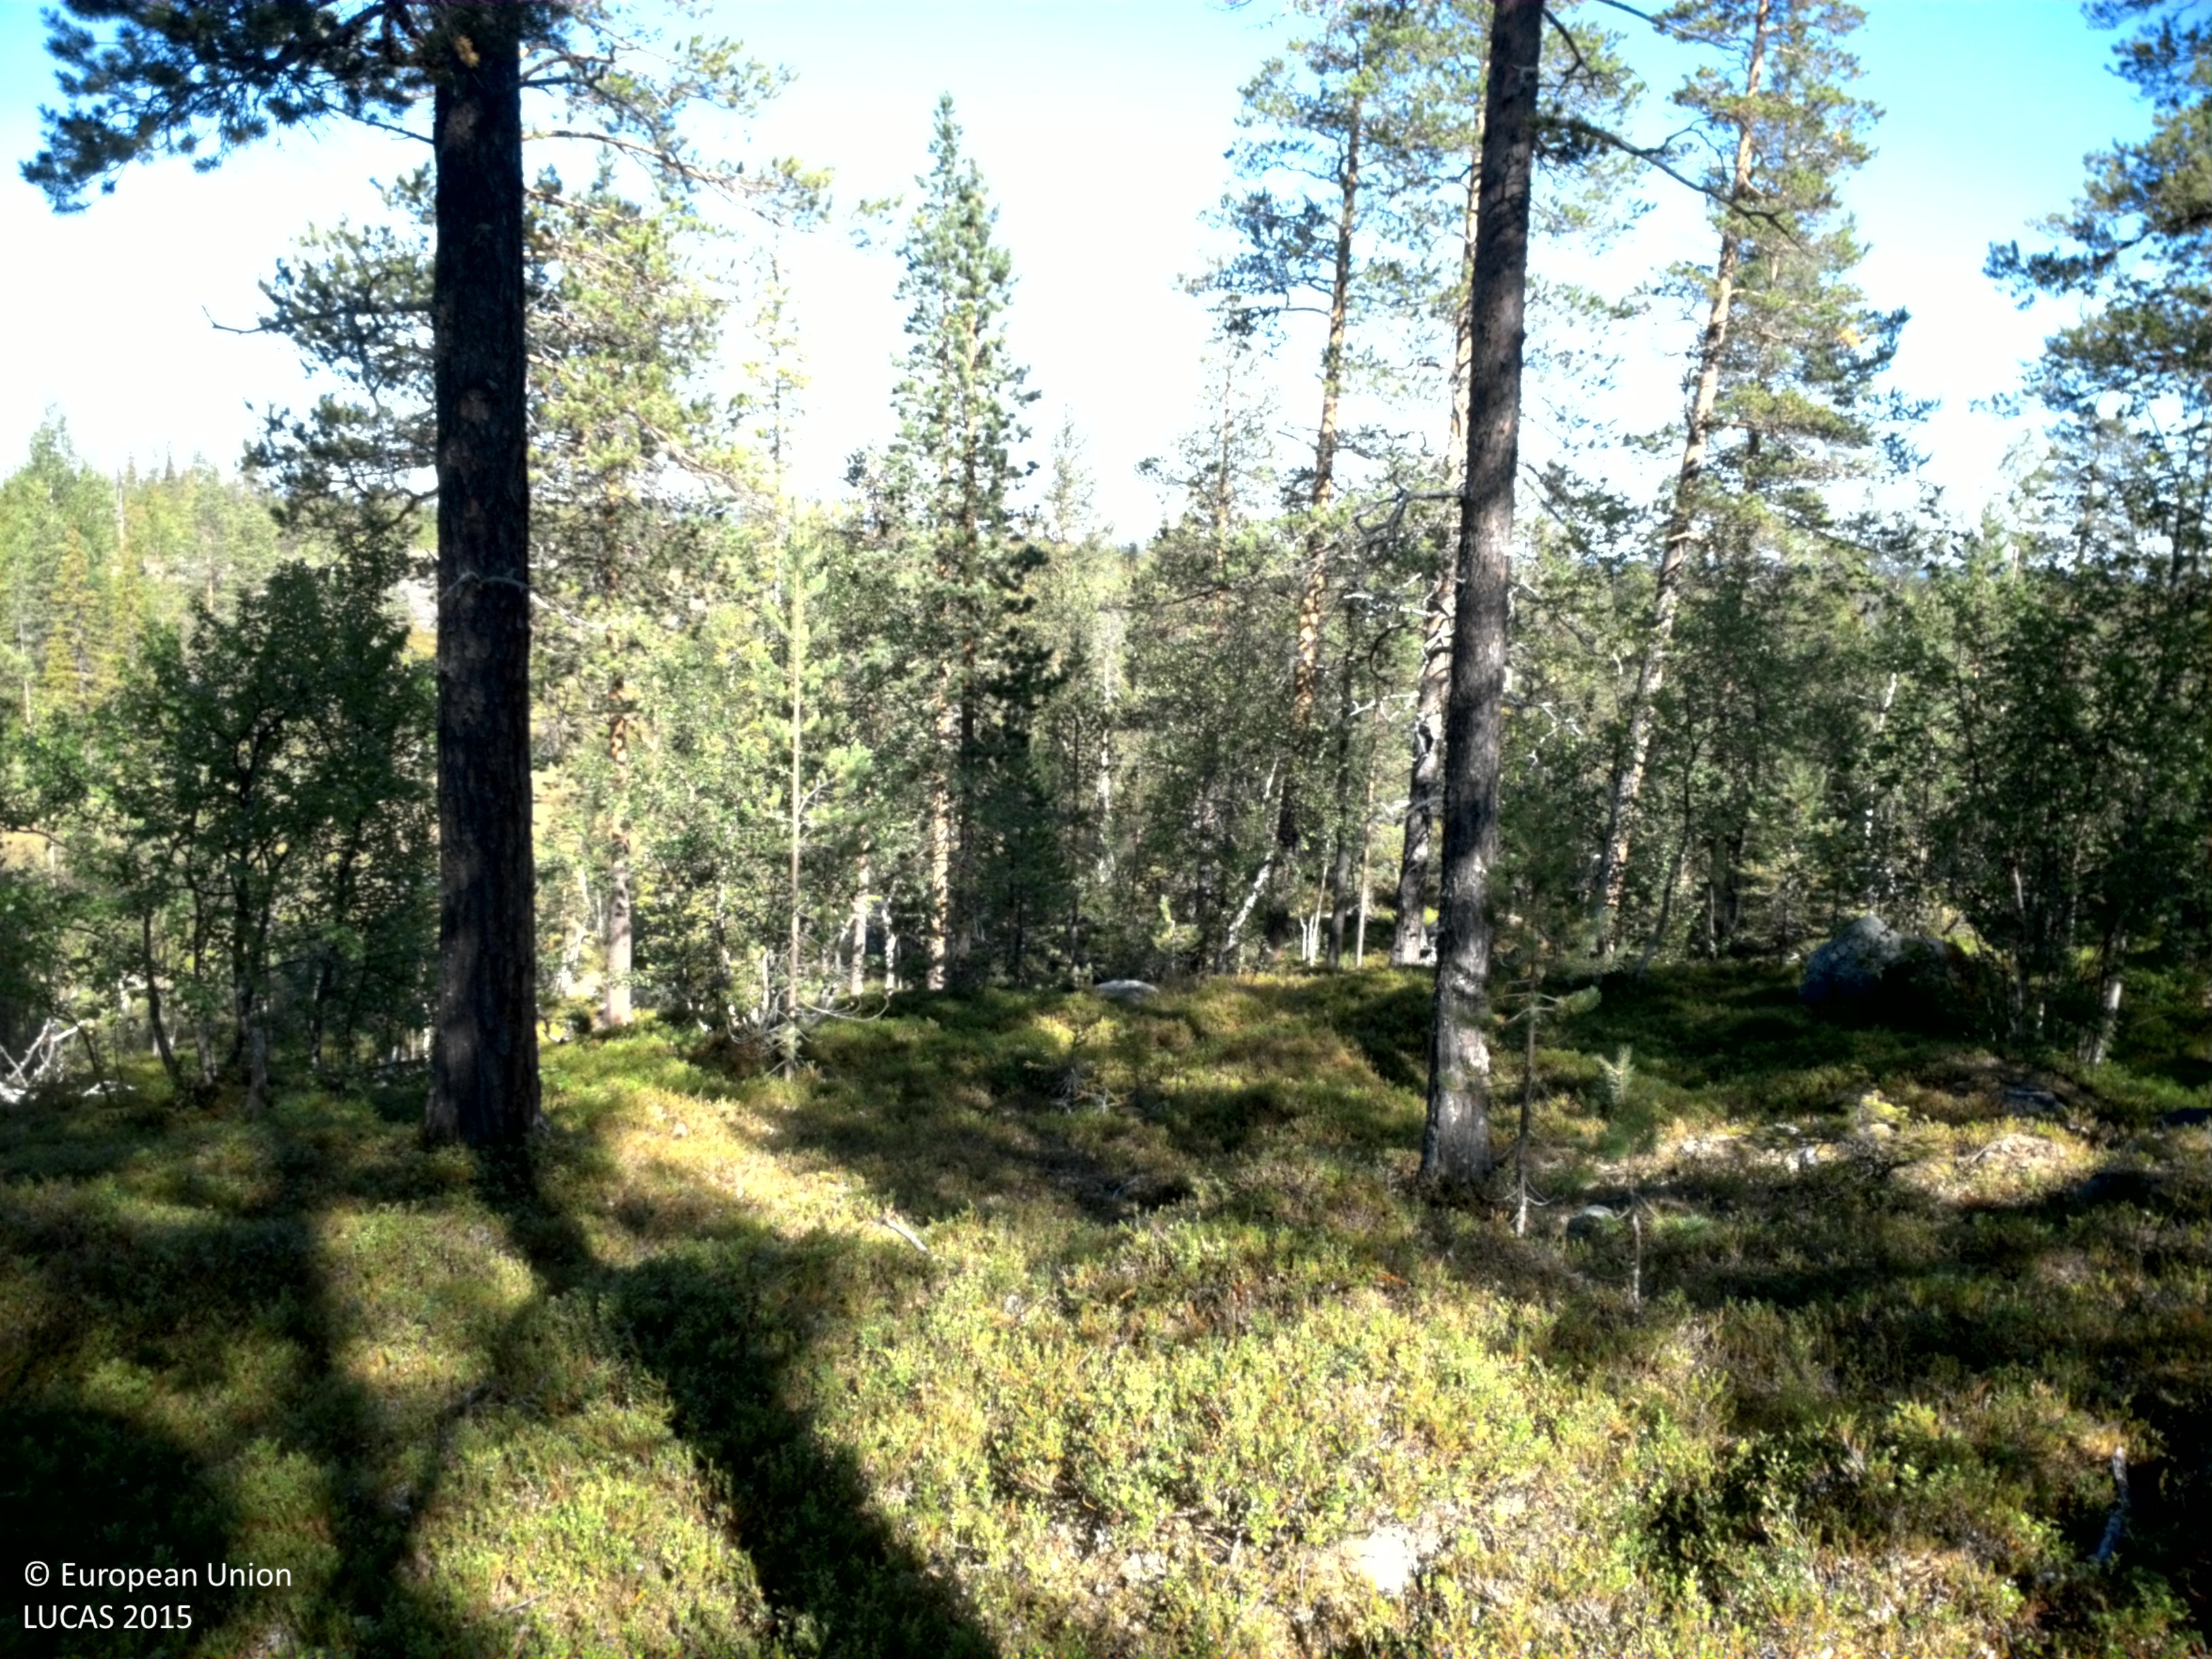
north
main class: Woodland
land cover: Pine dominated coniferous woodland
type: boreal forest
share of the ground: 25 - 50 %
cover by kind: shrubs 65 %, coniferous forest trees 25 %, broadleaved forest trees 5 %, consolidated bare surface 5 %
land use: Forestry
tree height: > 5 m
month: August
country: SE
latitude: 66.6333
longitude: 18.7393
